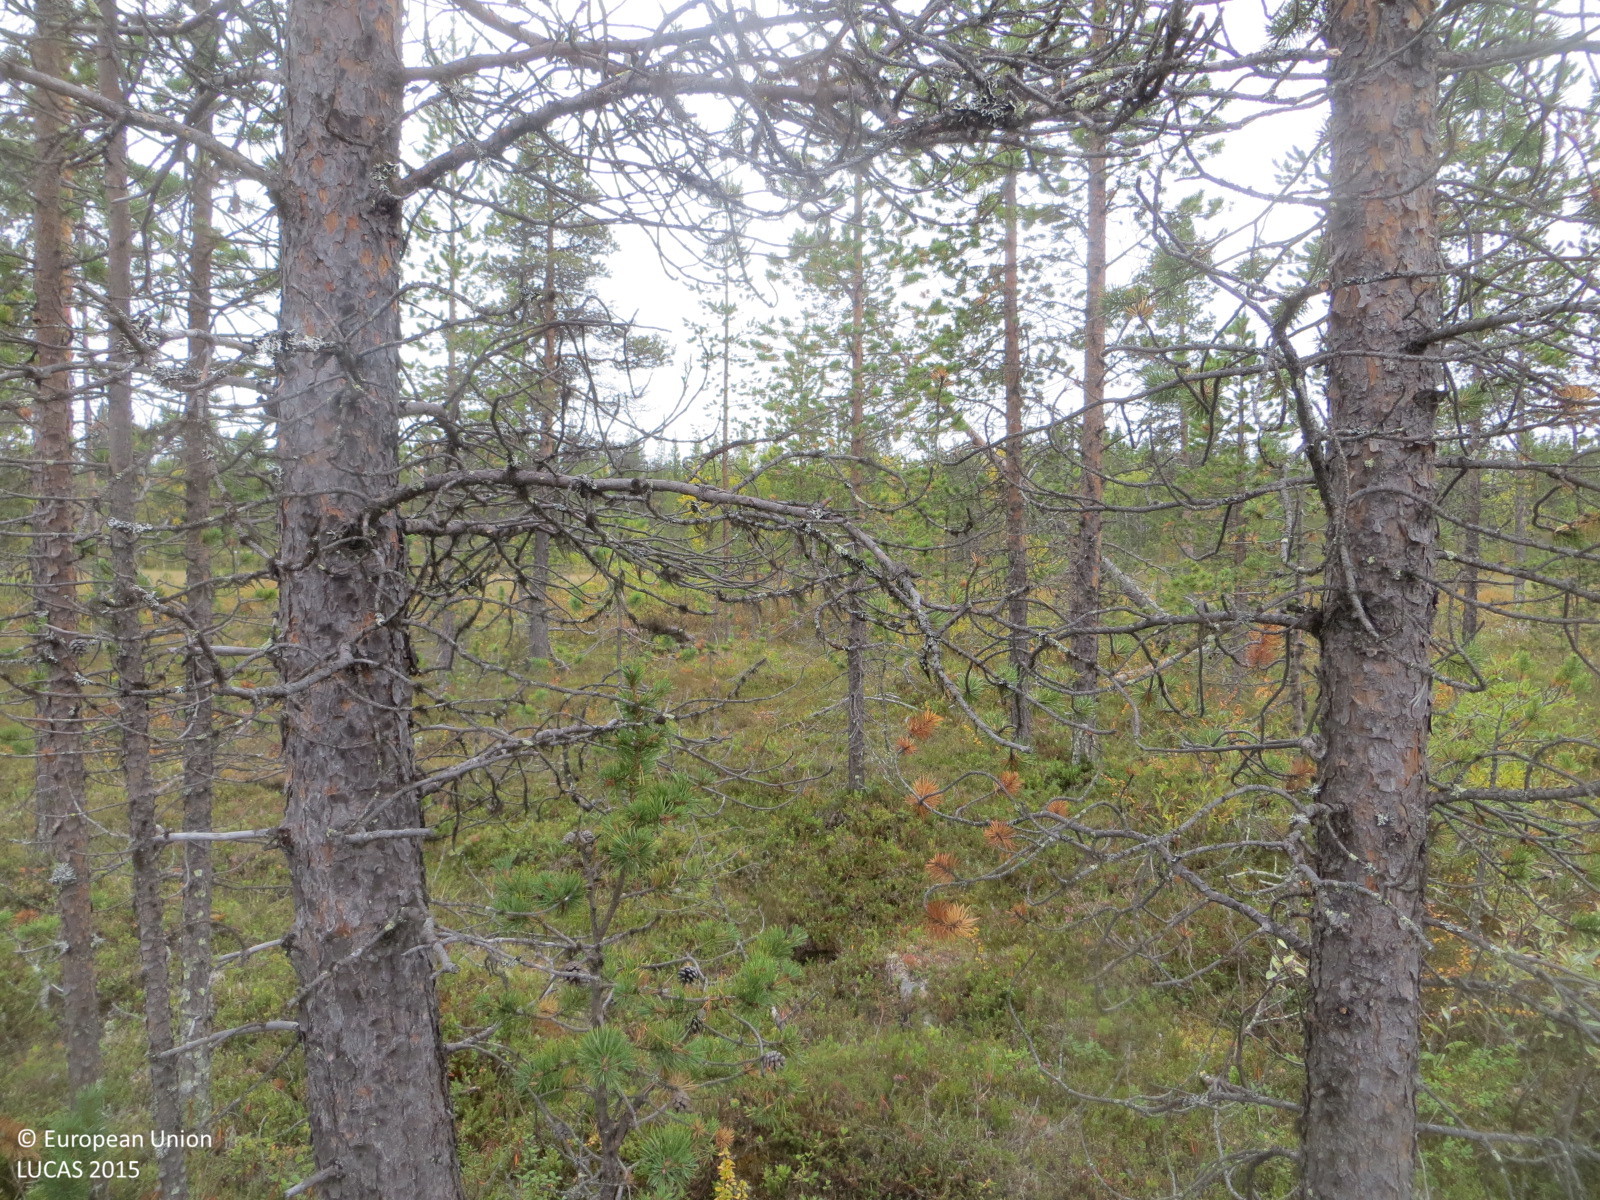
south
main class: Woodland
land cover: Pine dominated coniferous woodland
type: mire and swamp forests
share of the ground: 50 - 75 %
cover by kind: coniferous forest trees 55 %, shrubs 45 %
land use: Forestry
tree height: > 5 m
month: September
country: FI
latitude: 68.3366
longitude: 22.9360
